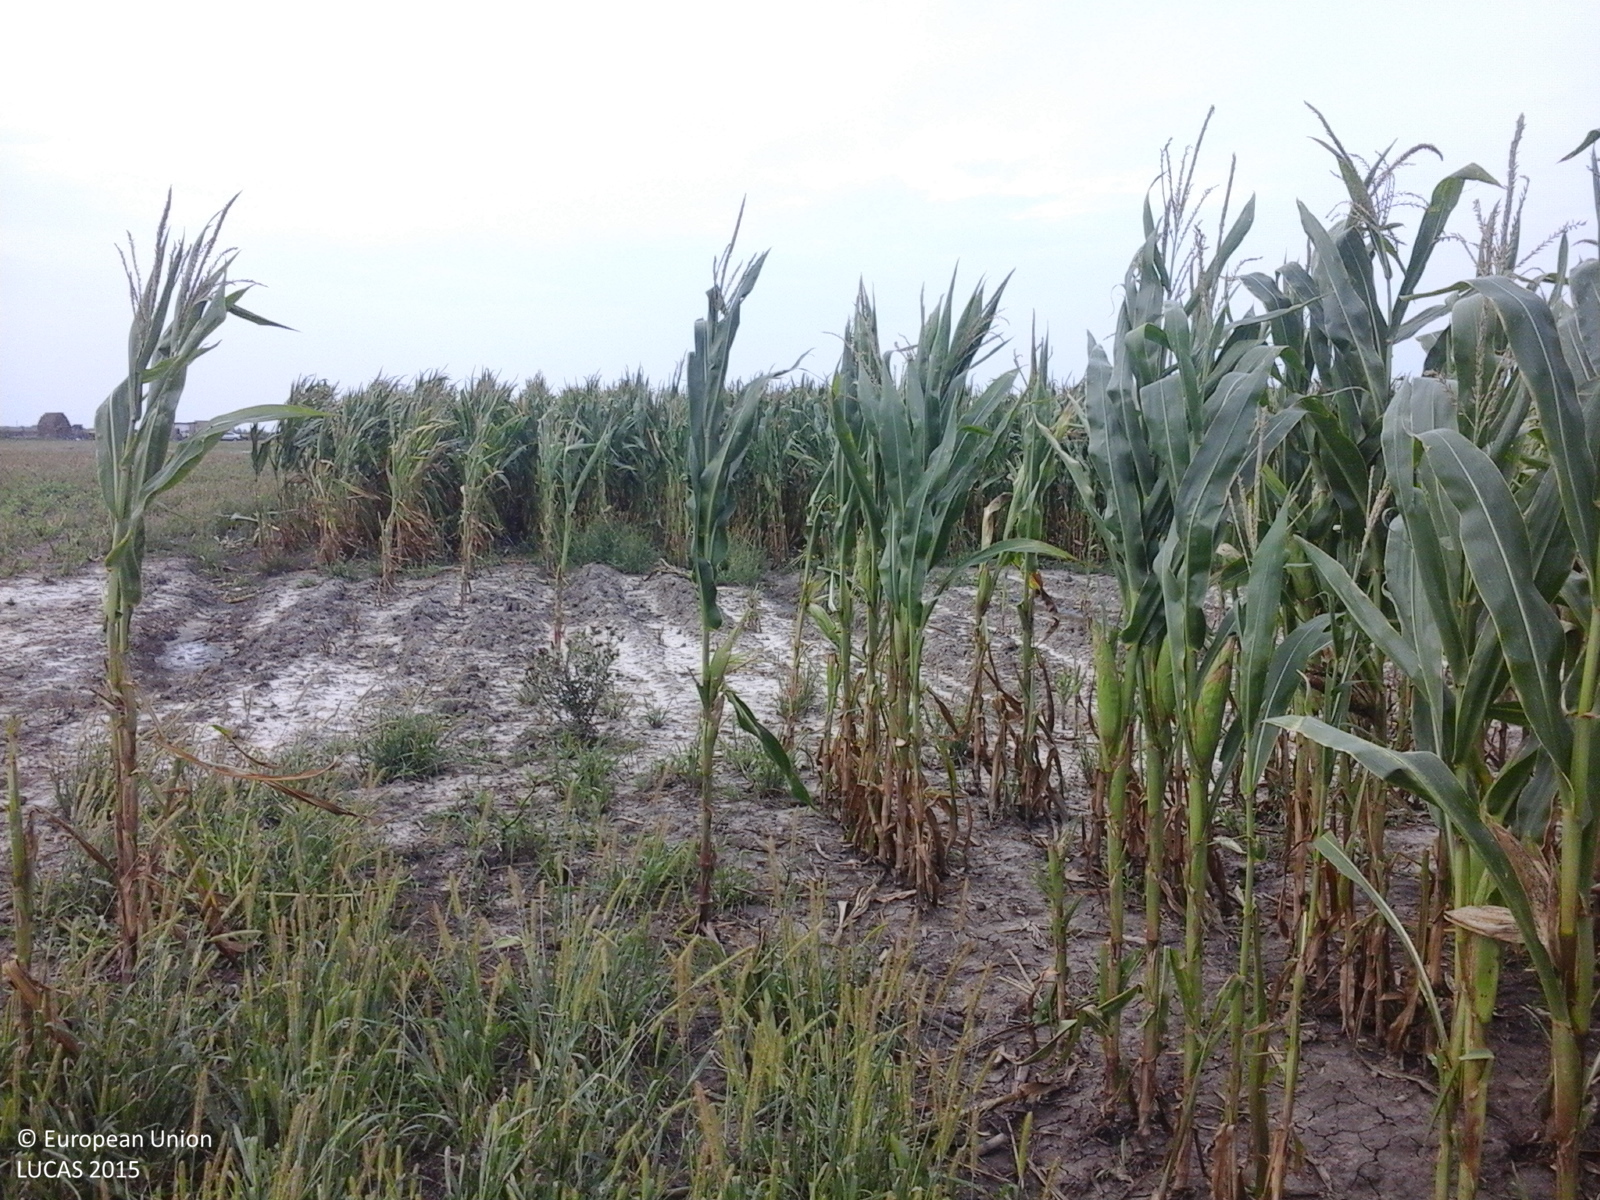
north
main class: Cropland
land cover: Maize
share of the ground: > 75 %
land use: Agriculture (excluding fallow land and kitchen gardens)
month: August
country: RO
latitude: 46.2516
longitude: 21.2013
